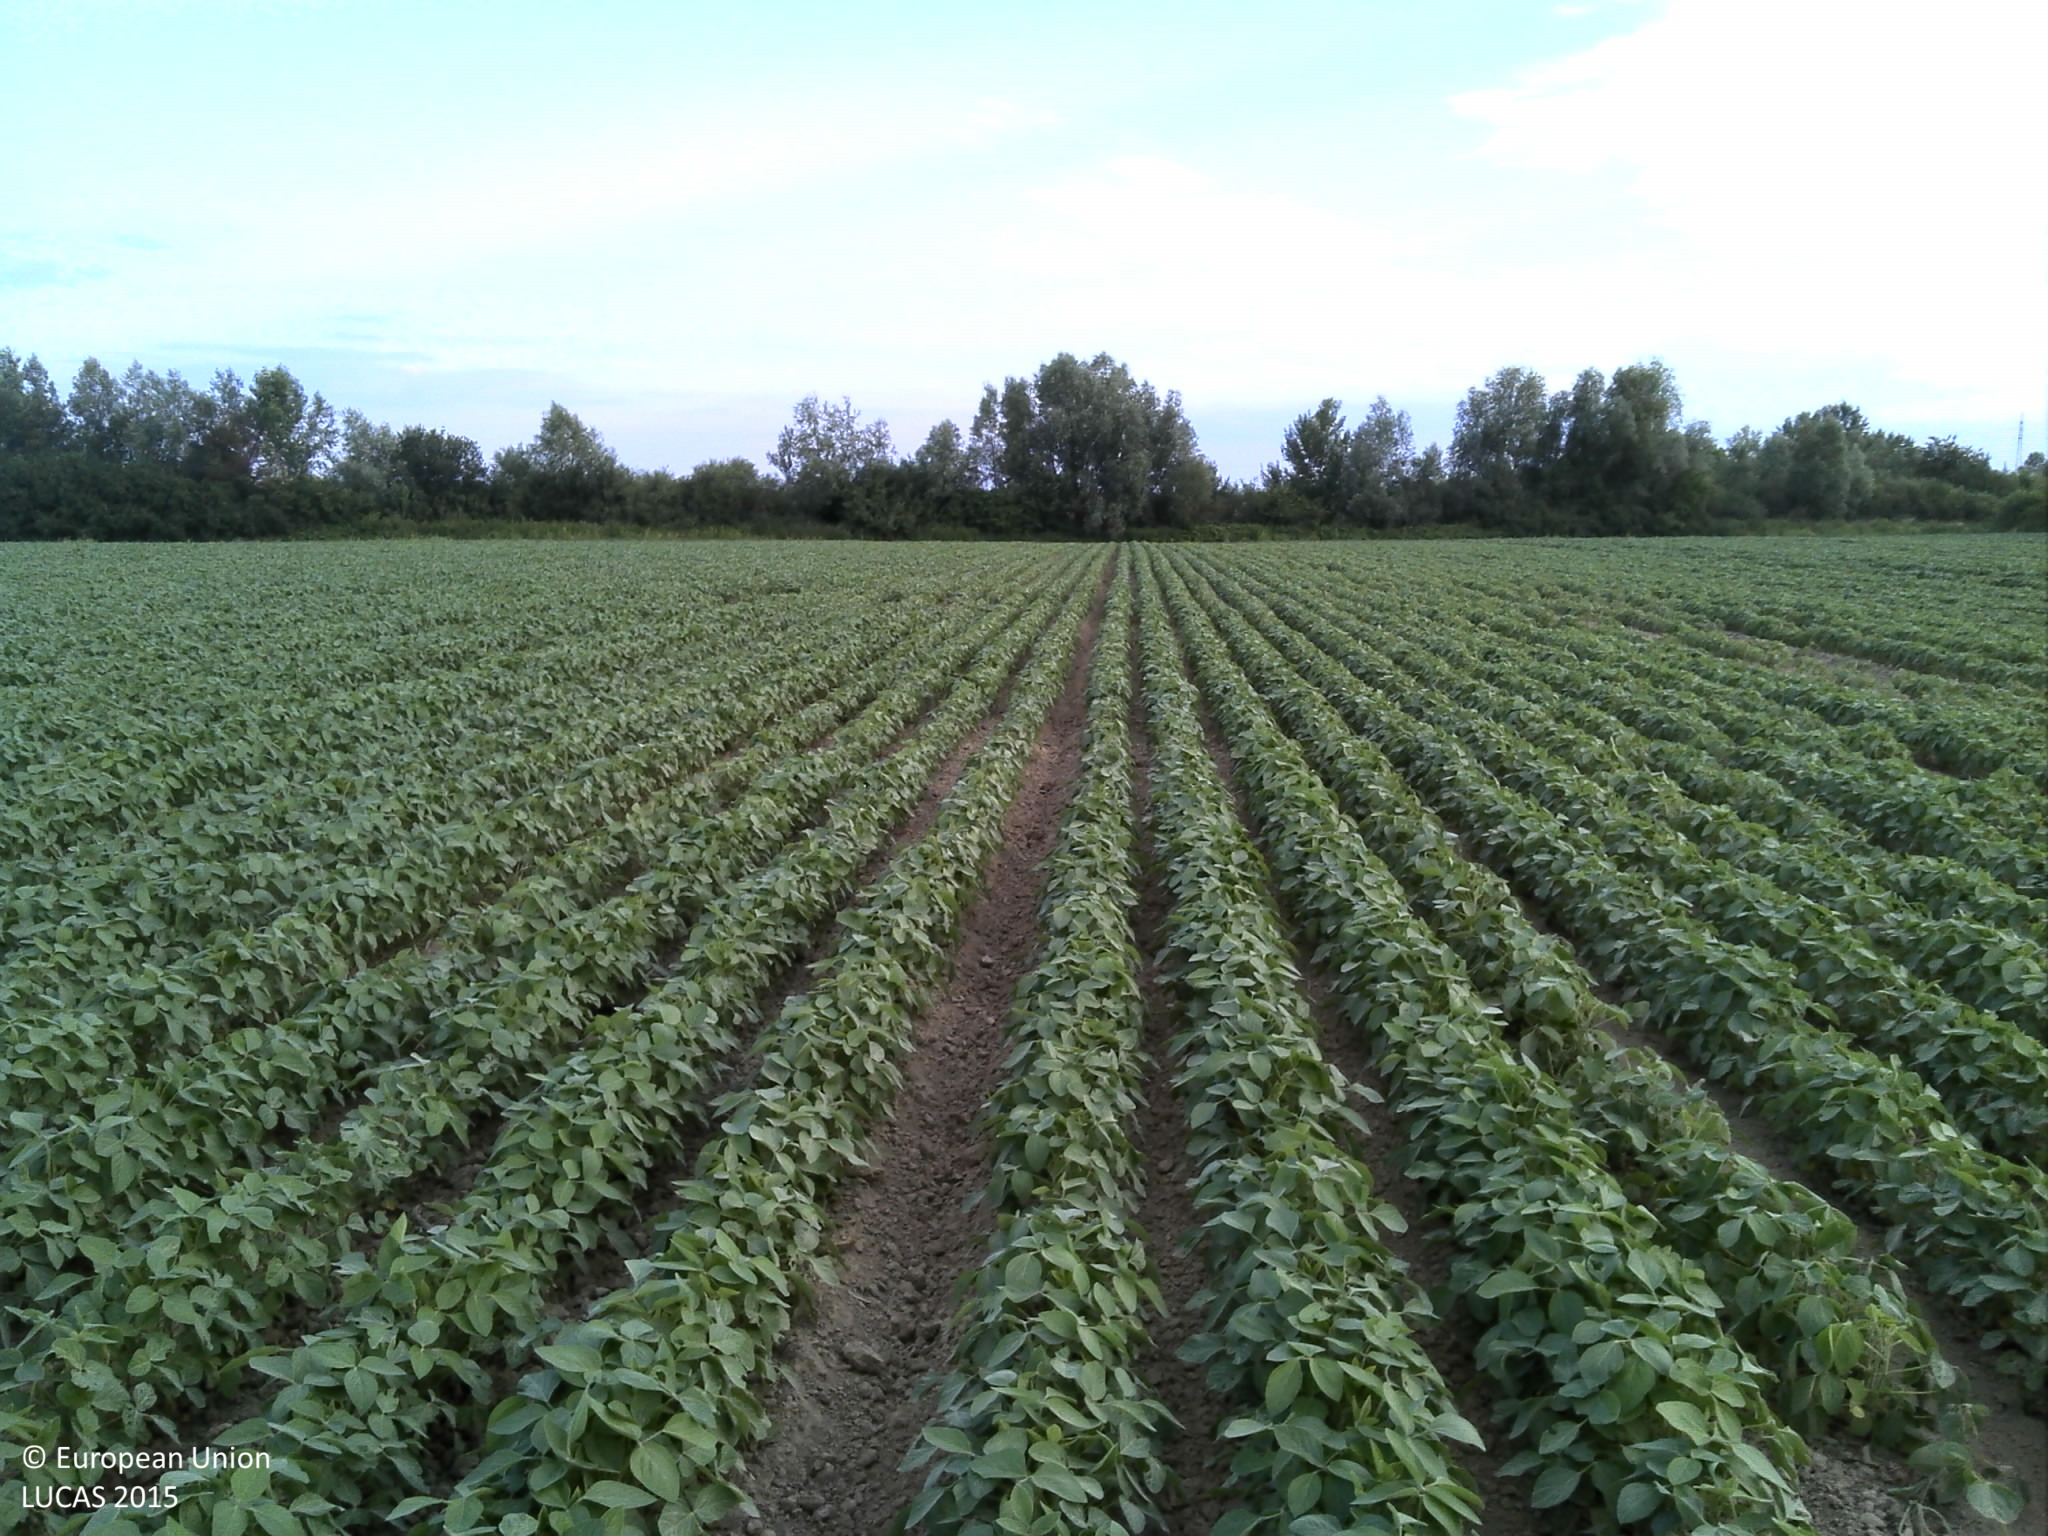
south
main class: Cropland
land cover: Soya
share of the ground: 50 - 75 %
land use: Agriculture (excluding fallow land and kitchen gardens)
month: June
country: HR
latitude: 45.7250
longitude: 18.2420
